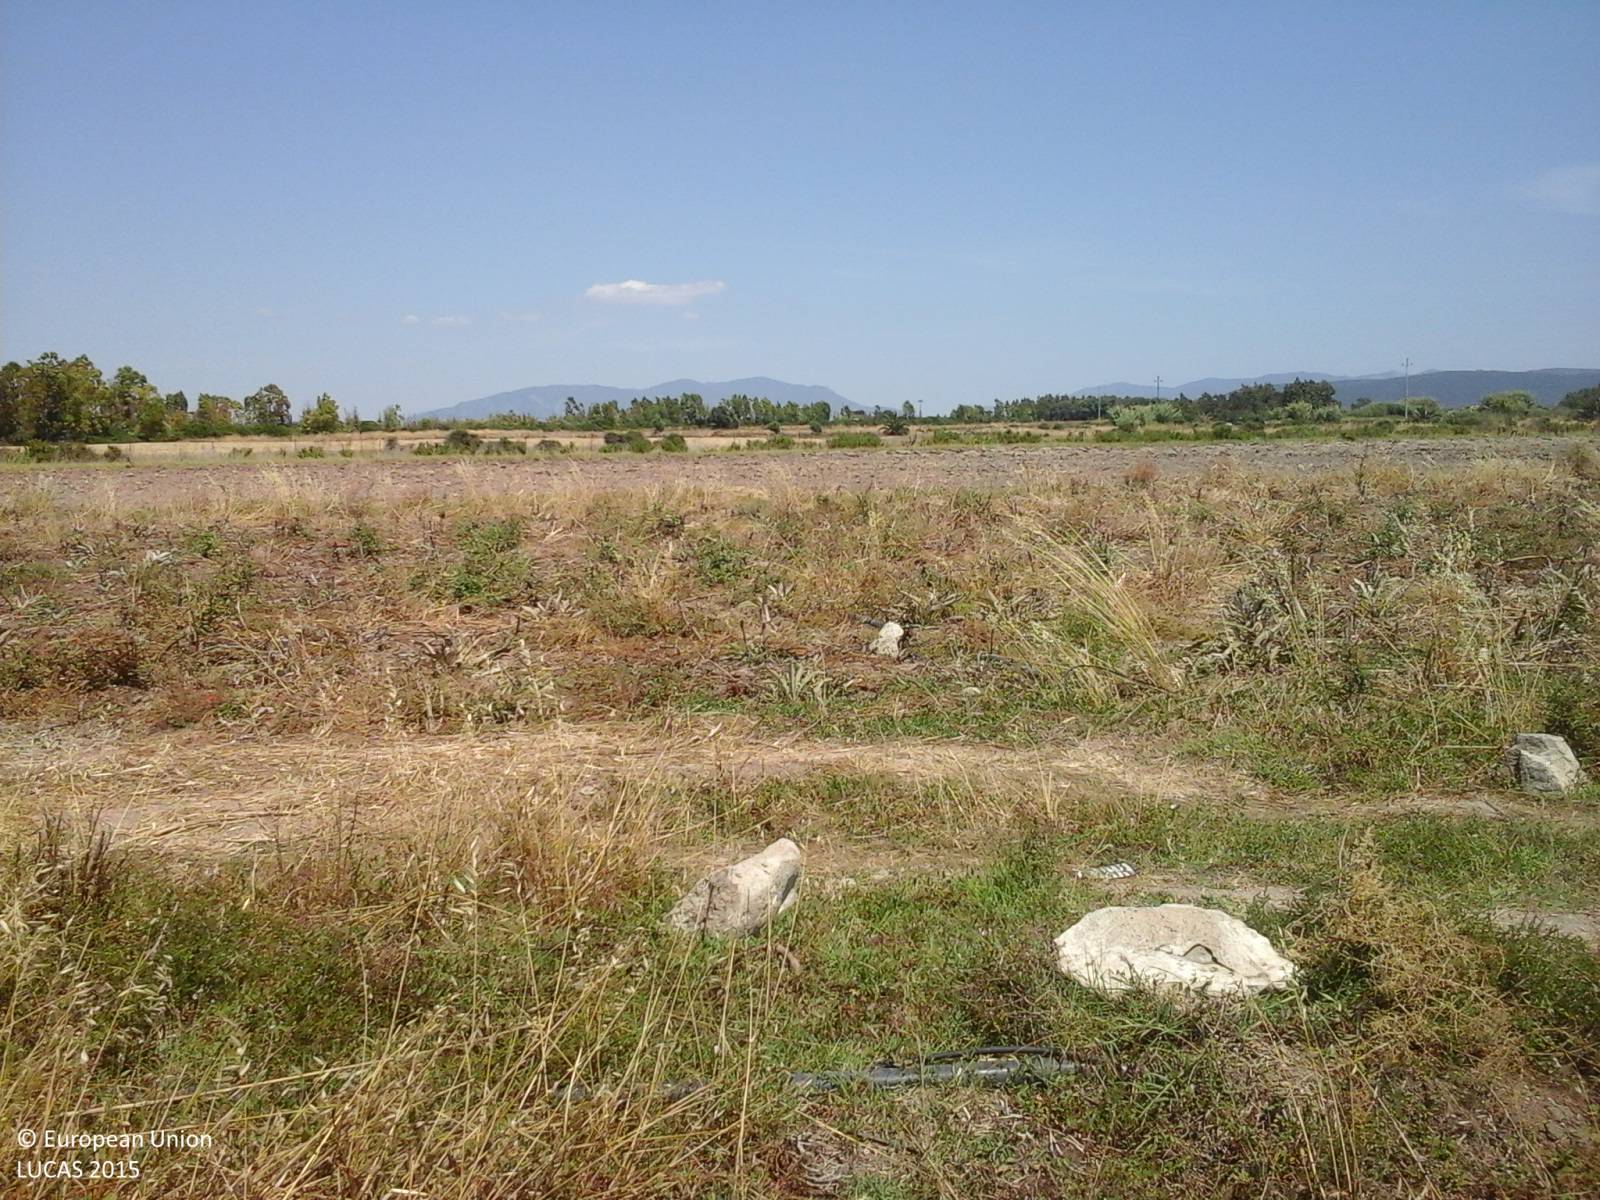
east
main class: Cropland
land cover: Other fresh vegetables
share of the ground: > 75 %
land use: Agriculture (excluding fallow land and kitchen gardens)
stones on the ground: 25 - 50 %
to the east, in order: Other fresh vegetables; Tracks; Spontaneously vegetated surfaces; Other bare soil; Ditches and canals; Shrubland without tree cover; Fences; Durum wheat; Oats
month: June
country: IT
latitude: 39.0611
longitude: 8.5645
